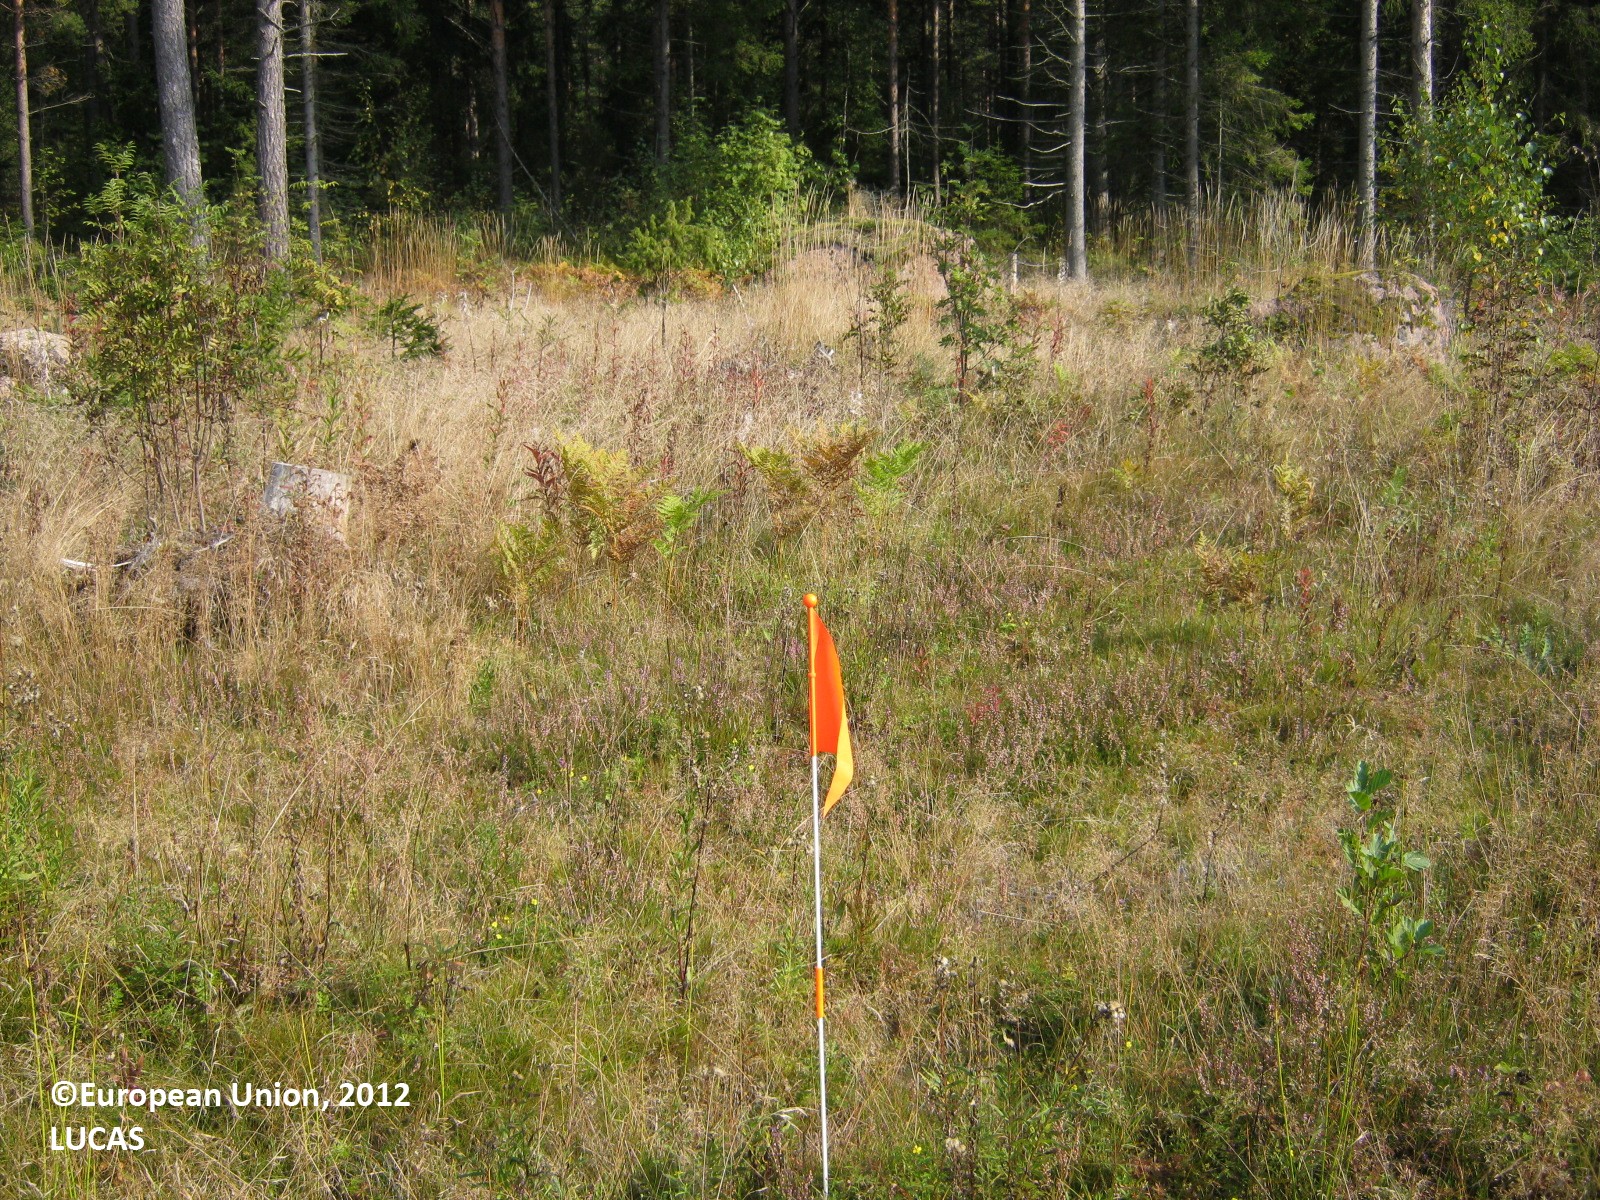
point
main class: Woodland
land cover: Broadleaved woodland
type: boreal forest
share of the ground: 25 - 50 %
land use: Forestry
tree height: < 5 m
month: September
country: FI
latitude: 60.5285
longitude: 27.7039
